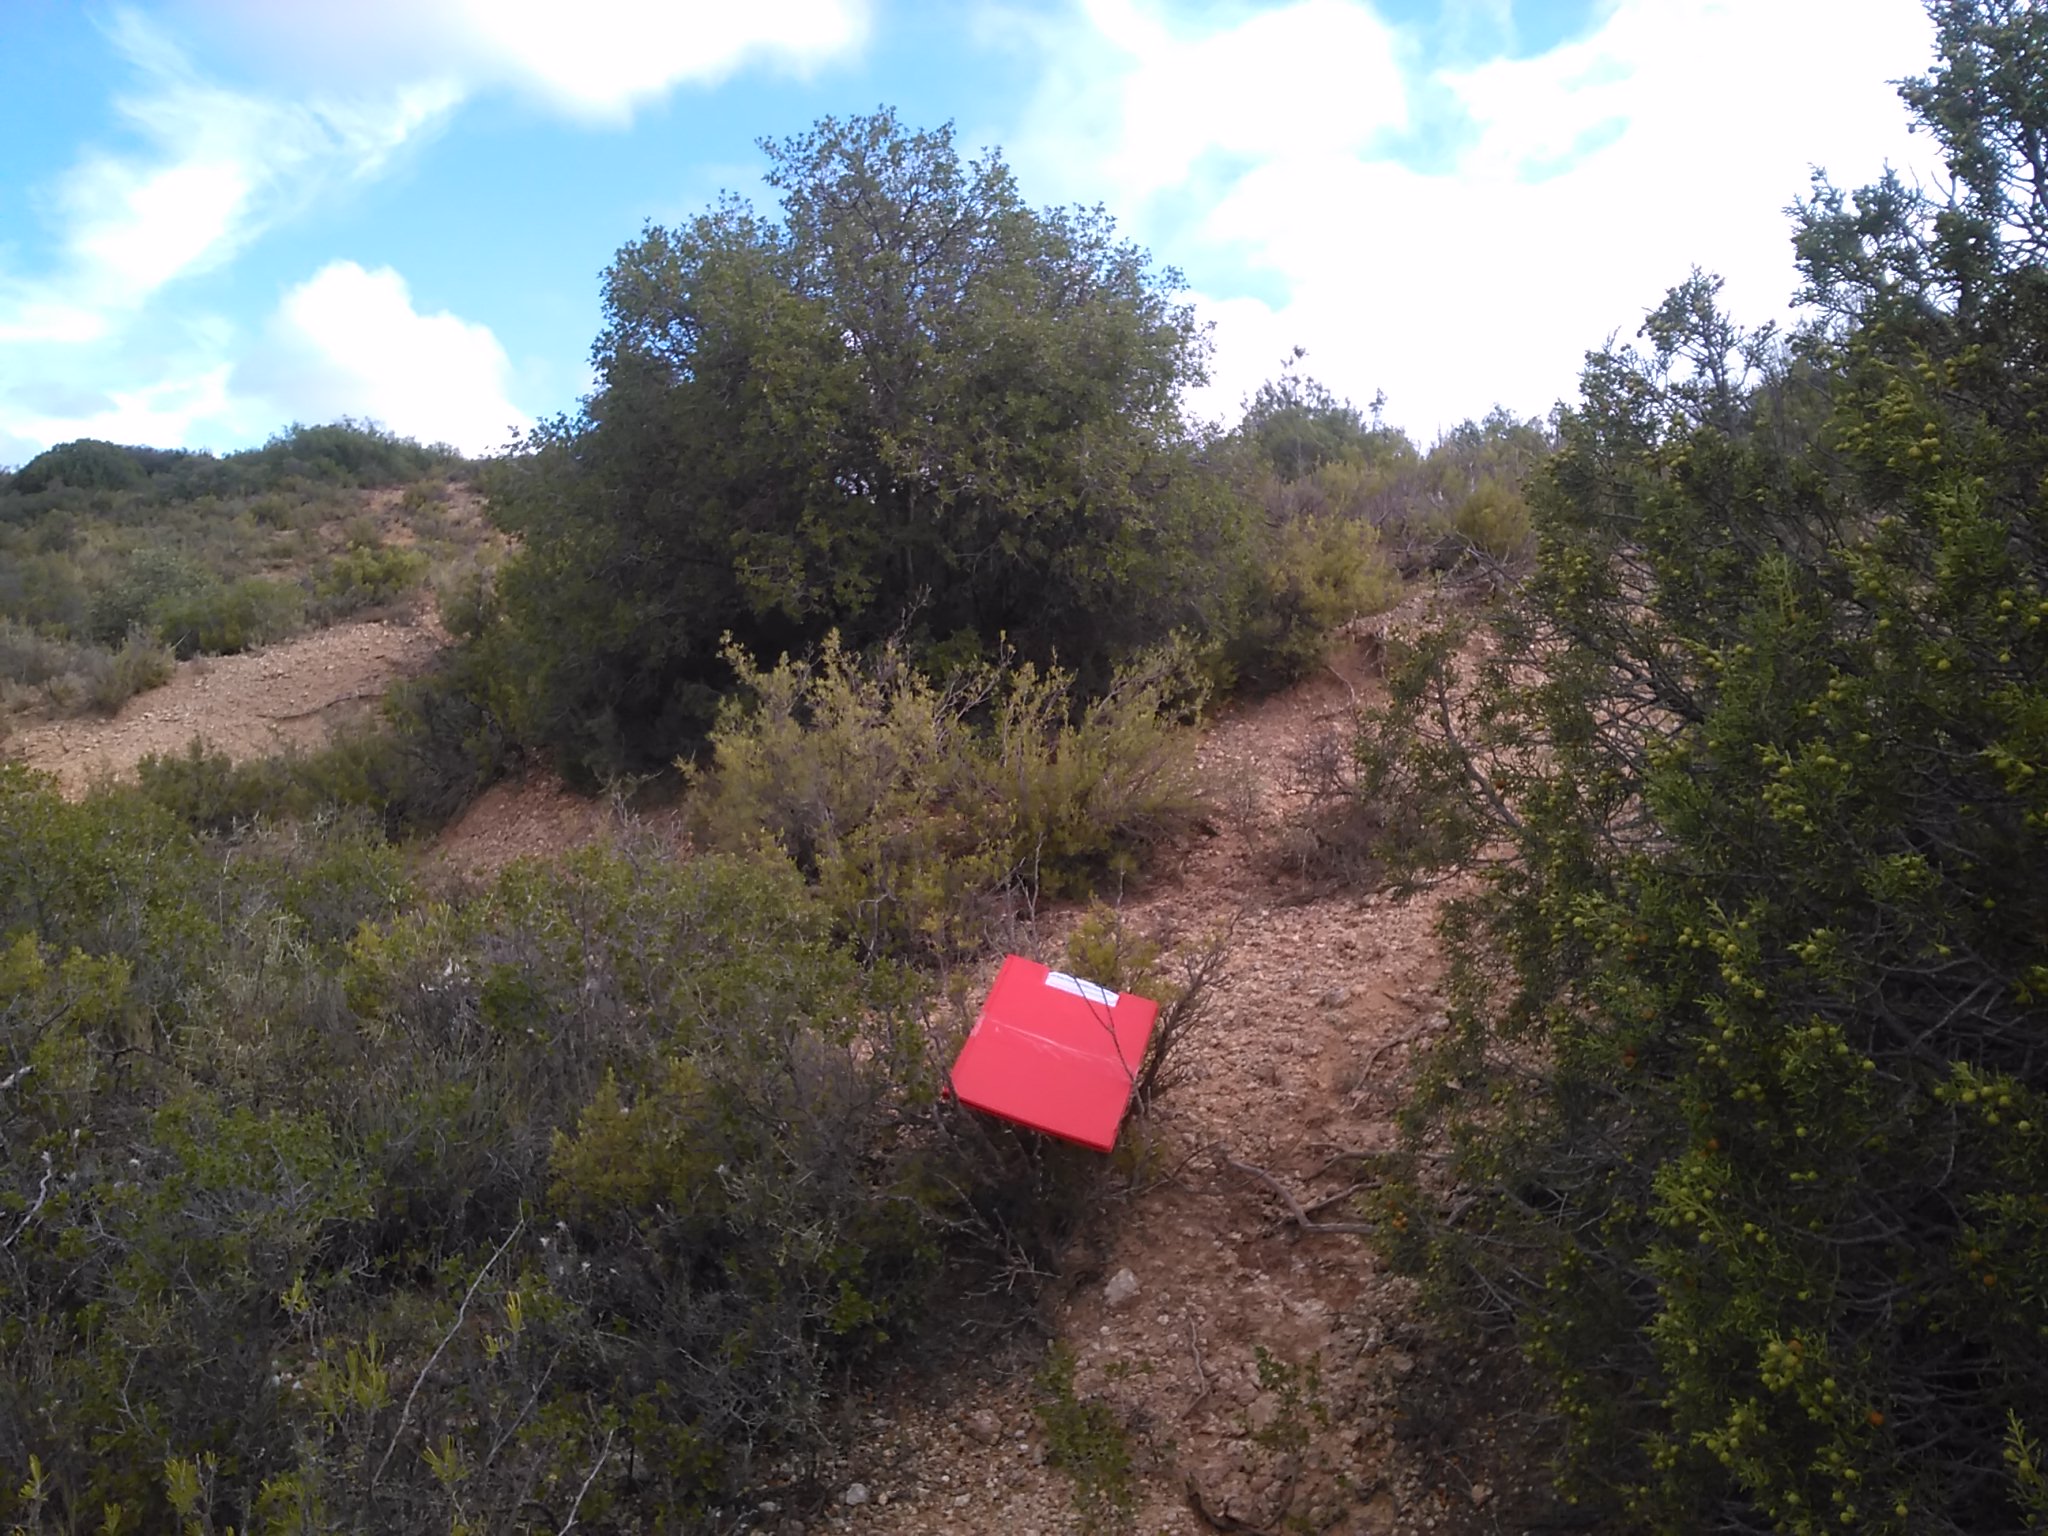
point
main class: Woodland
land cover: Other mixed woodland
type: coniferous forest of the mediterranean region
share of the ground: 25 - 50 %
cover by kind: shrubs 30 %, unconsolidated bare surface 25 %, coniferous forest trees 20 %, broadleaved forest trees 20 %, herbaceous plants 5 %
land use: Semi-natural and natural areas not in use
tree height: < 5 m
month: July
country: ES
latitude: 41.3548
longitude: -1.9934
